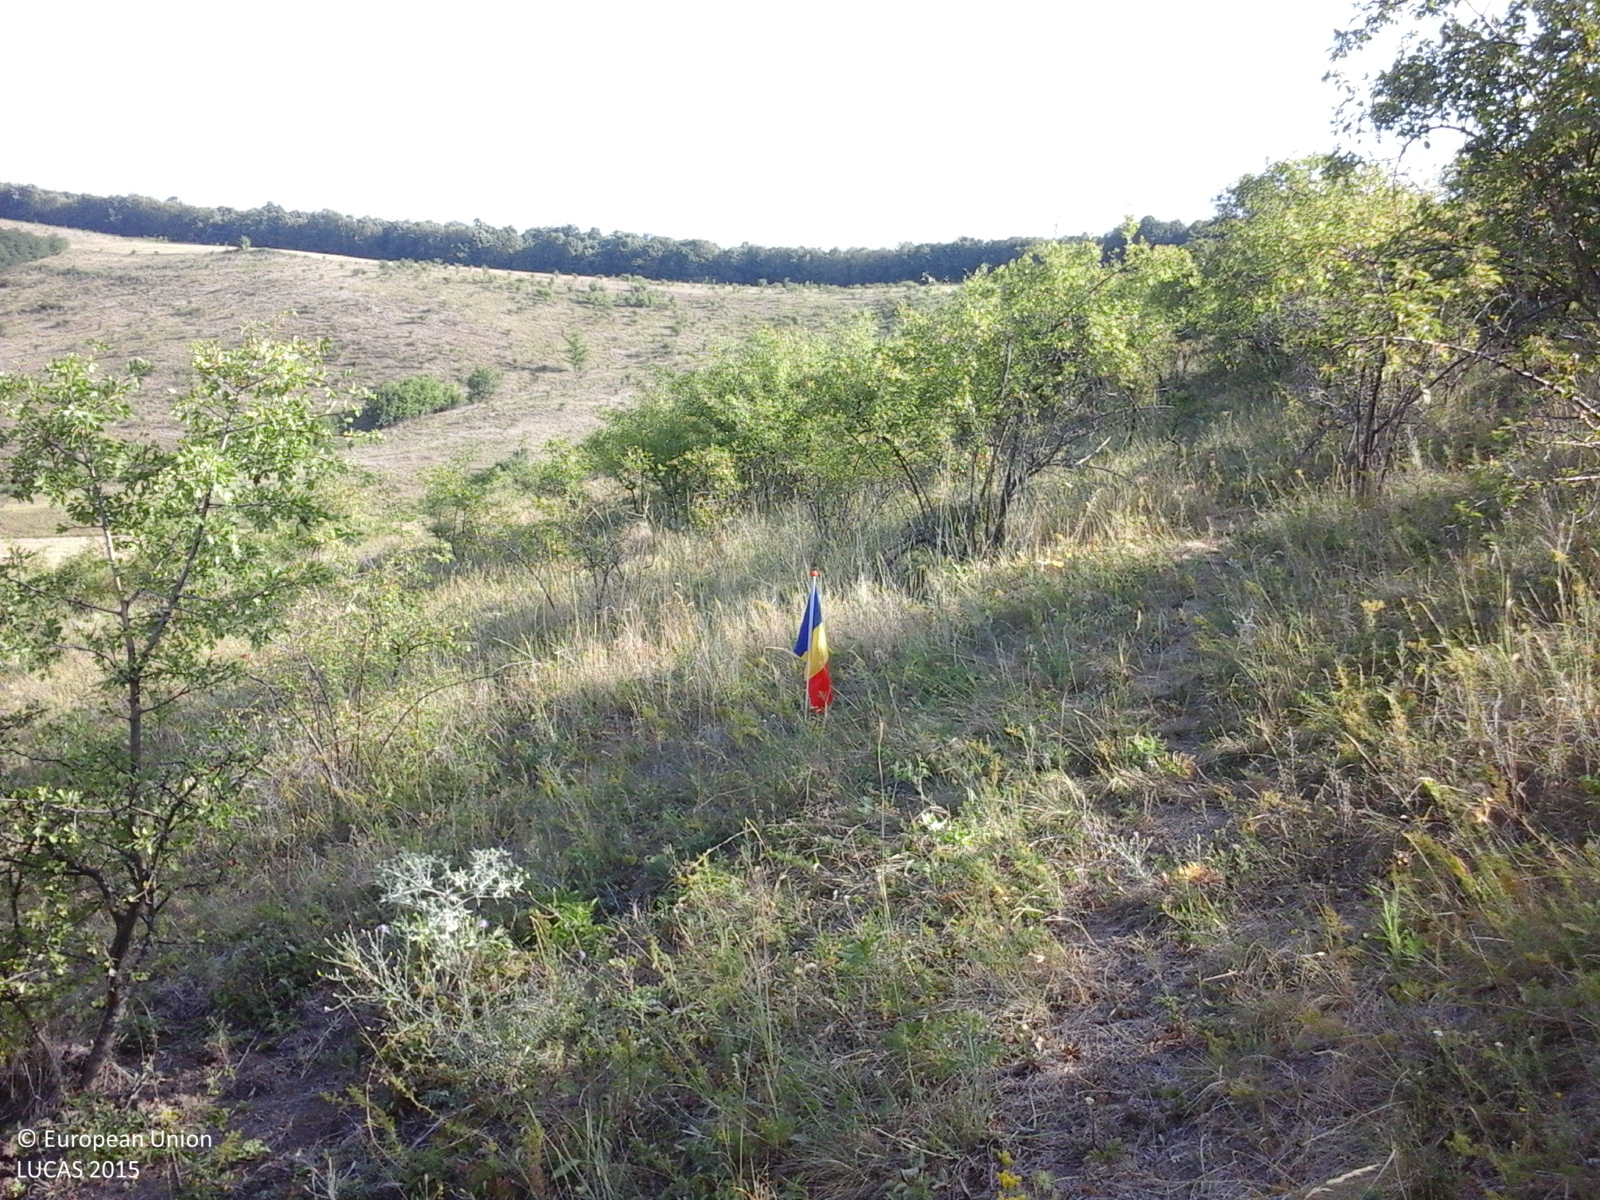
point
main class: Shrubland
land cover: Shrubland with sparse tree cover
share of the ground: > 75 %
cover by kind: herbaceous plants 75 %, shrubs 20 %, broadleaved forest trees 5 %
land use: Semi-natural and natural areas not in use
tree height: > 5 m
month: July
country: RO
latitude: 46.5628
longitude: 27.2047
